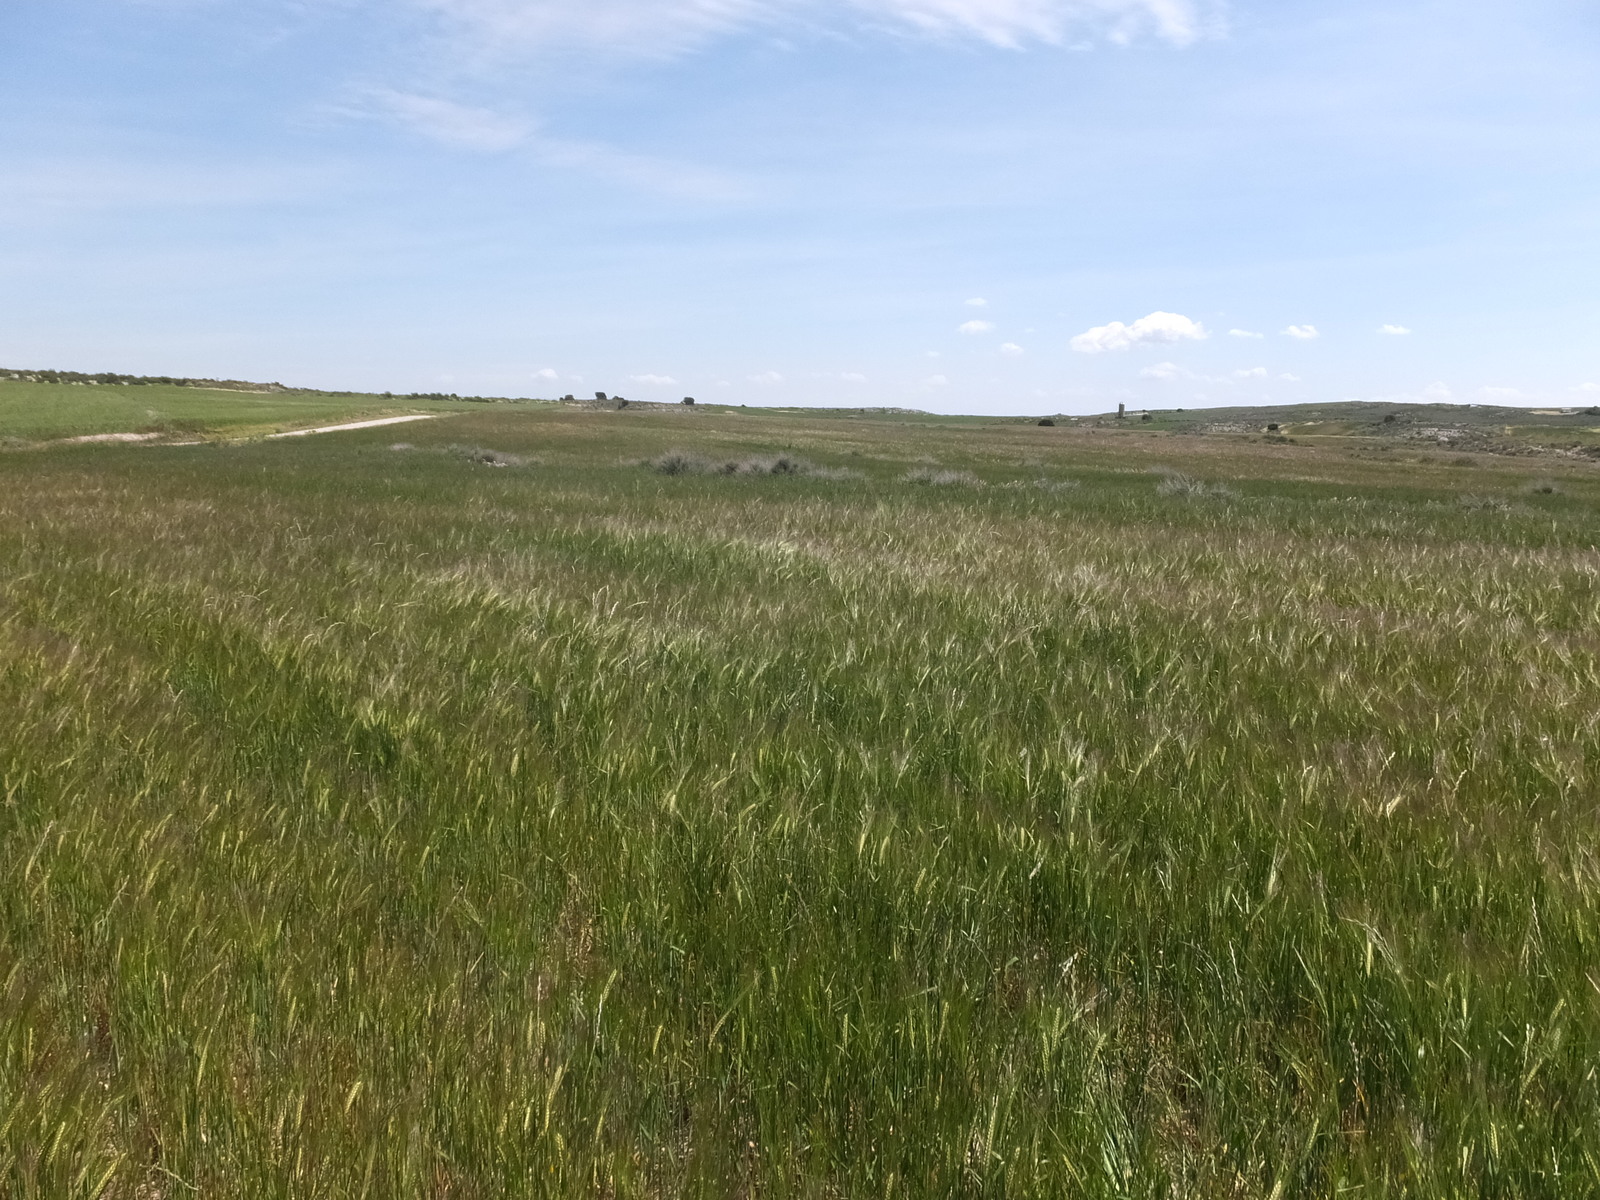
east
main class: Cropland
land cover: Barley
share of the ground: > 75 %
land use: Agriculture (excluding fallow land and kitchen gardens)
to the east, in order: Barley; Shruby margins; Barley; Shruby margins; Barley
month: April
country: ES
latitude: 41.4975
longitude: -0.2340
